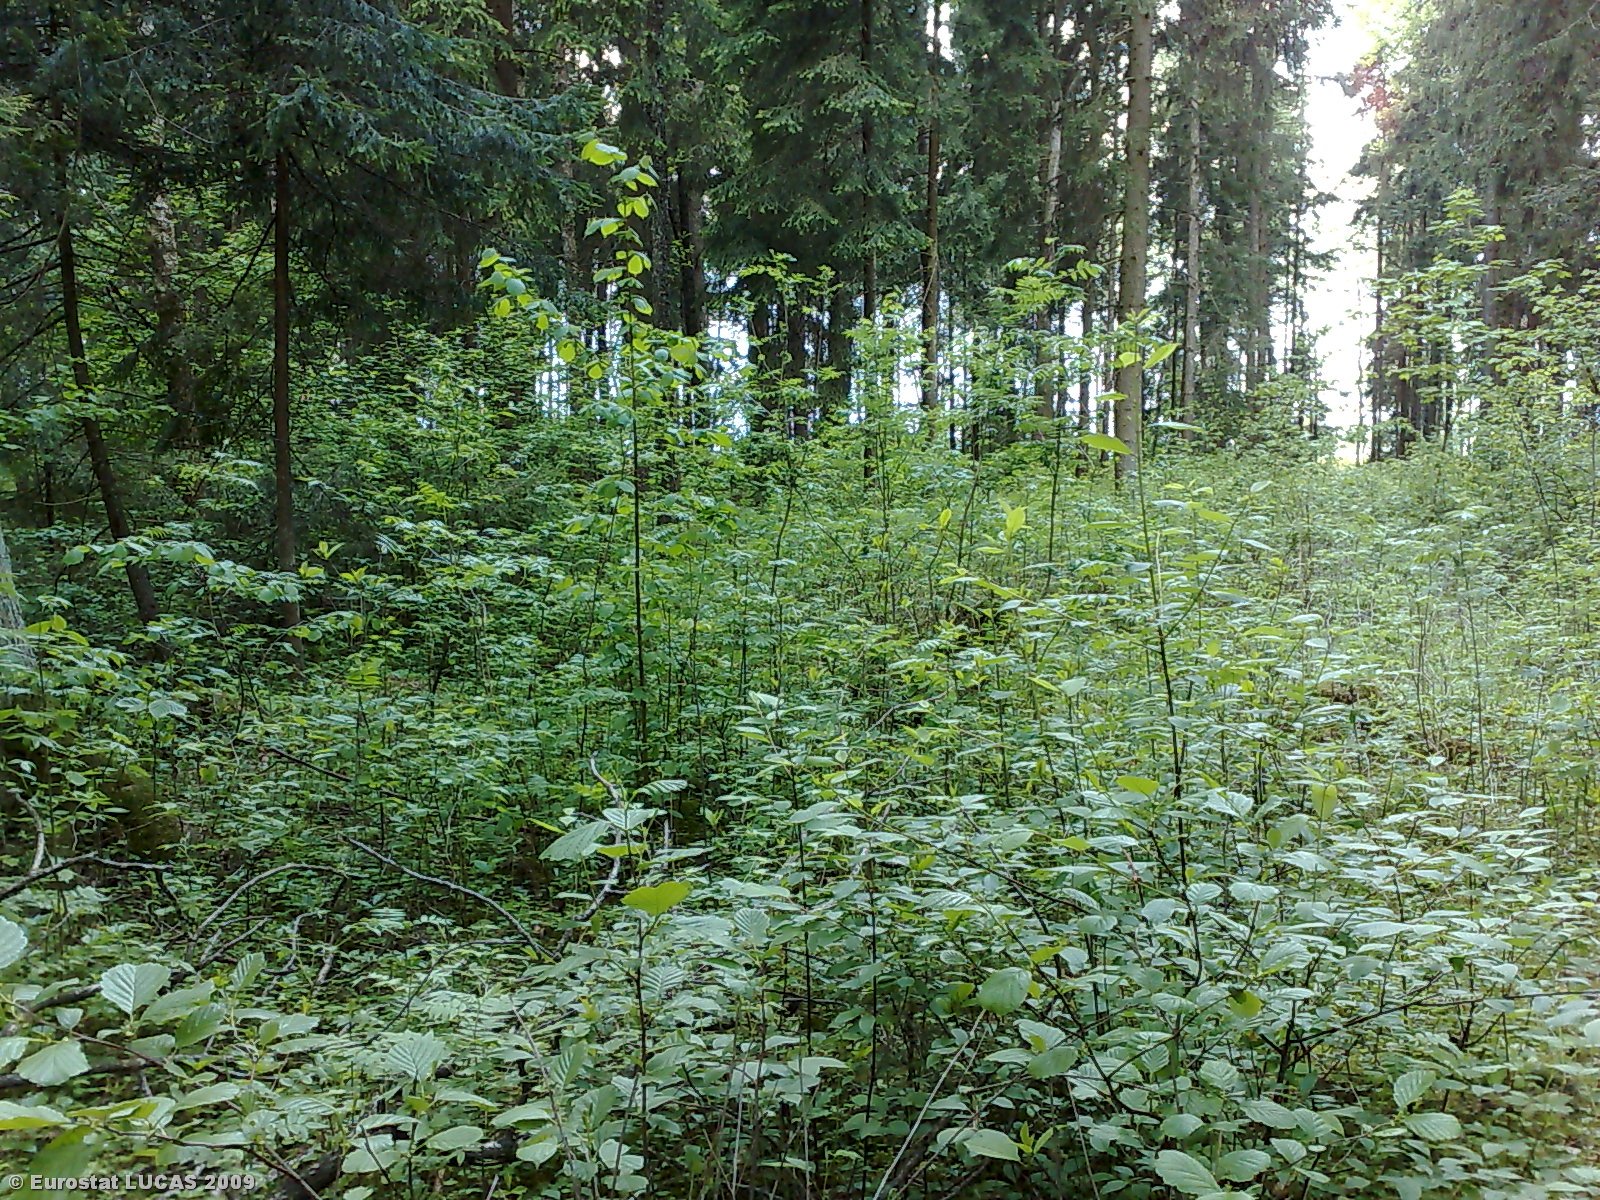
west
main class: Woodland
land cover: Mixed woodland
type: hemiboreal forest and nemoral coniferous forest and mixed broadleaved-coniferous forest
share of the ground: > 75 %
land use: Forestry
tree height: > 5 m
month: May
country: LT
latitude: 55.5968
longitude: 23.8446
